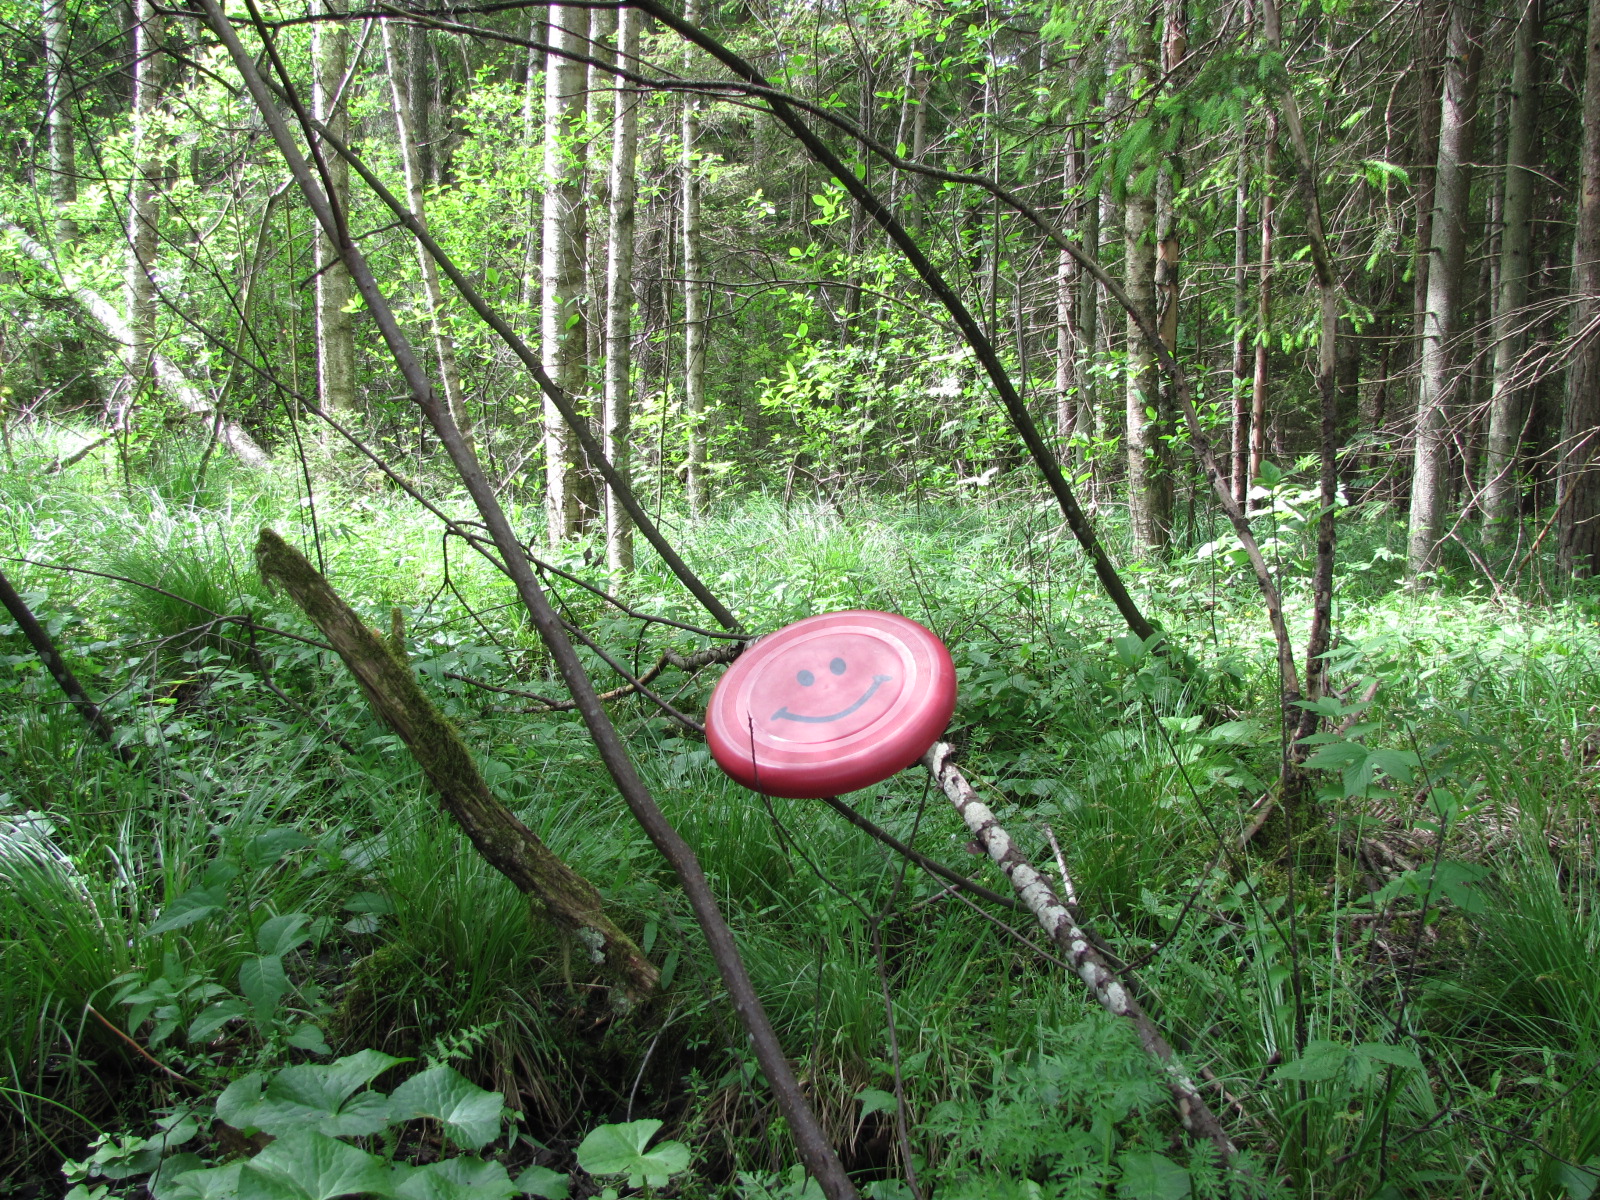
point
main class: Woodland
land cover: Spruce dominated mixed woodland
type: hemiboreal forest and nemoral coniferous forest and mixed broadleaved-coniferous forest
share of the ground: > 75 %
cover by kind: broadleaved forest trees 60 %, coniferous forest trees 40 %
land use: Forestry
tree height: > 5 m
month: June
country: LV
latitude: 56.6547
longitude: 23.8651
